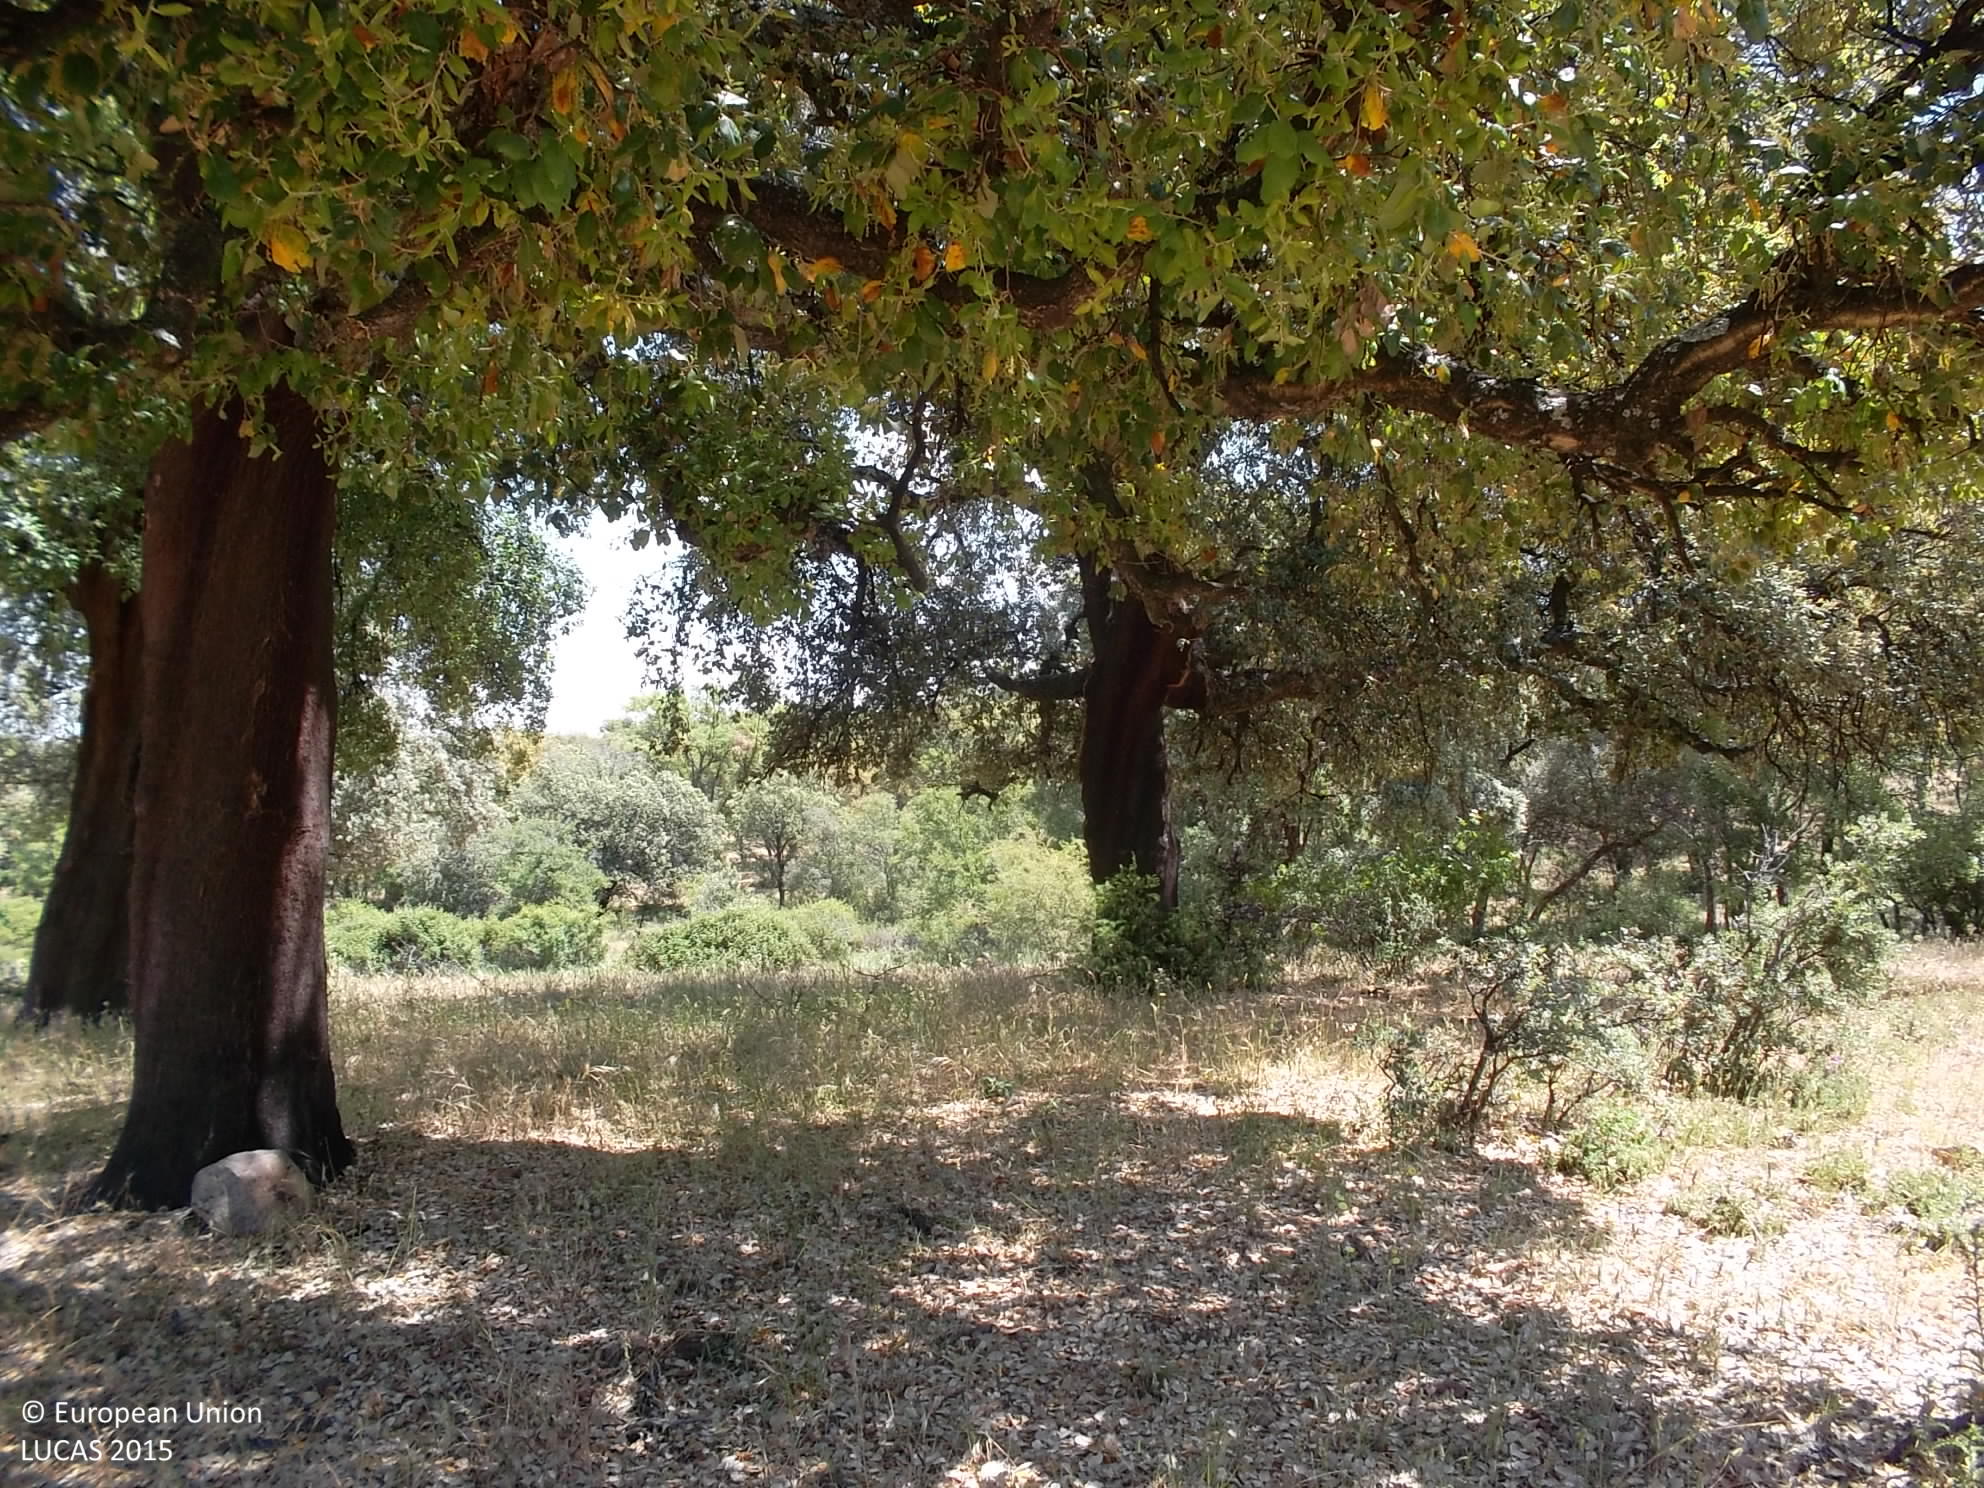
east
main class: Woodland
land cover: Broadleaved woodland
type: broadleaved evergreen forest
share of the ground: 25 - 50 %
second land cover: Spontaneously vegetated surfaces
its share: > 75 %
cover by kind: herbaceous plants 60 %, broadleaved forest trees 40 %
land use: Forestry
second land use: Agriculture (excluding fallow land and kitchen gardens)
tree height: > 5 m
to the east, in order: Tracks; Broadleaved woodland; Rivers and streams; Broadleaved woodland; Grassland with sparse tree/shrub cover
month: May
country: ES
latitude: 38.5422
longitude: -4.3723
